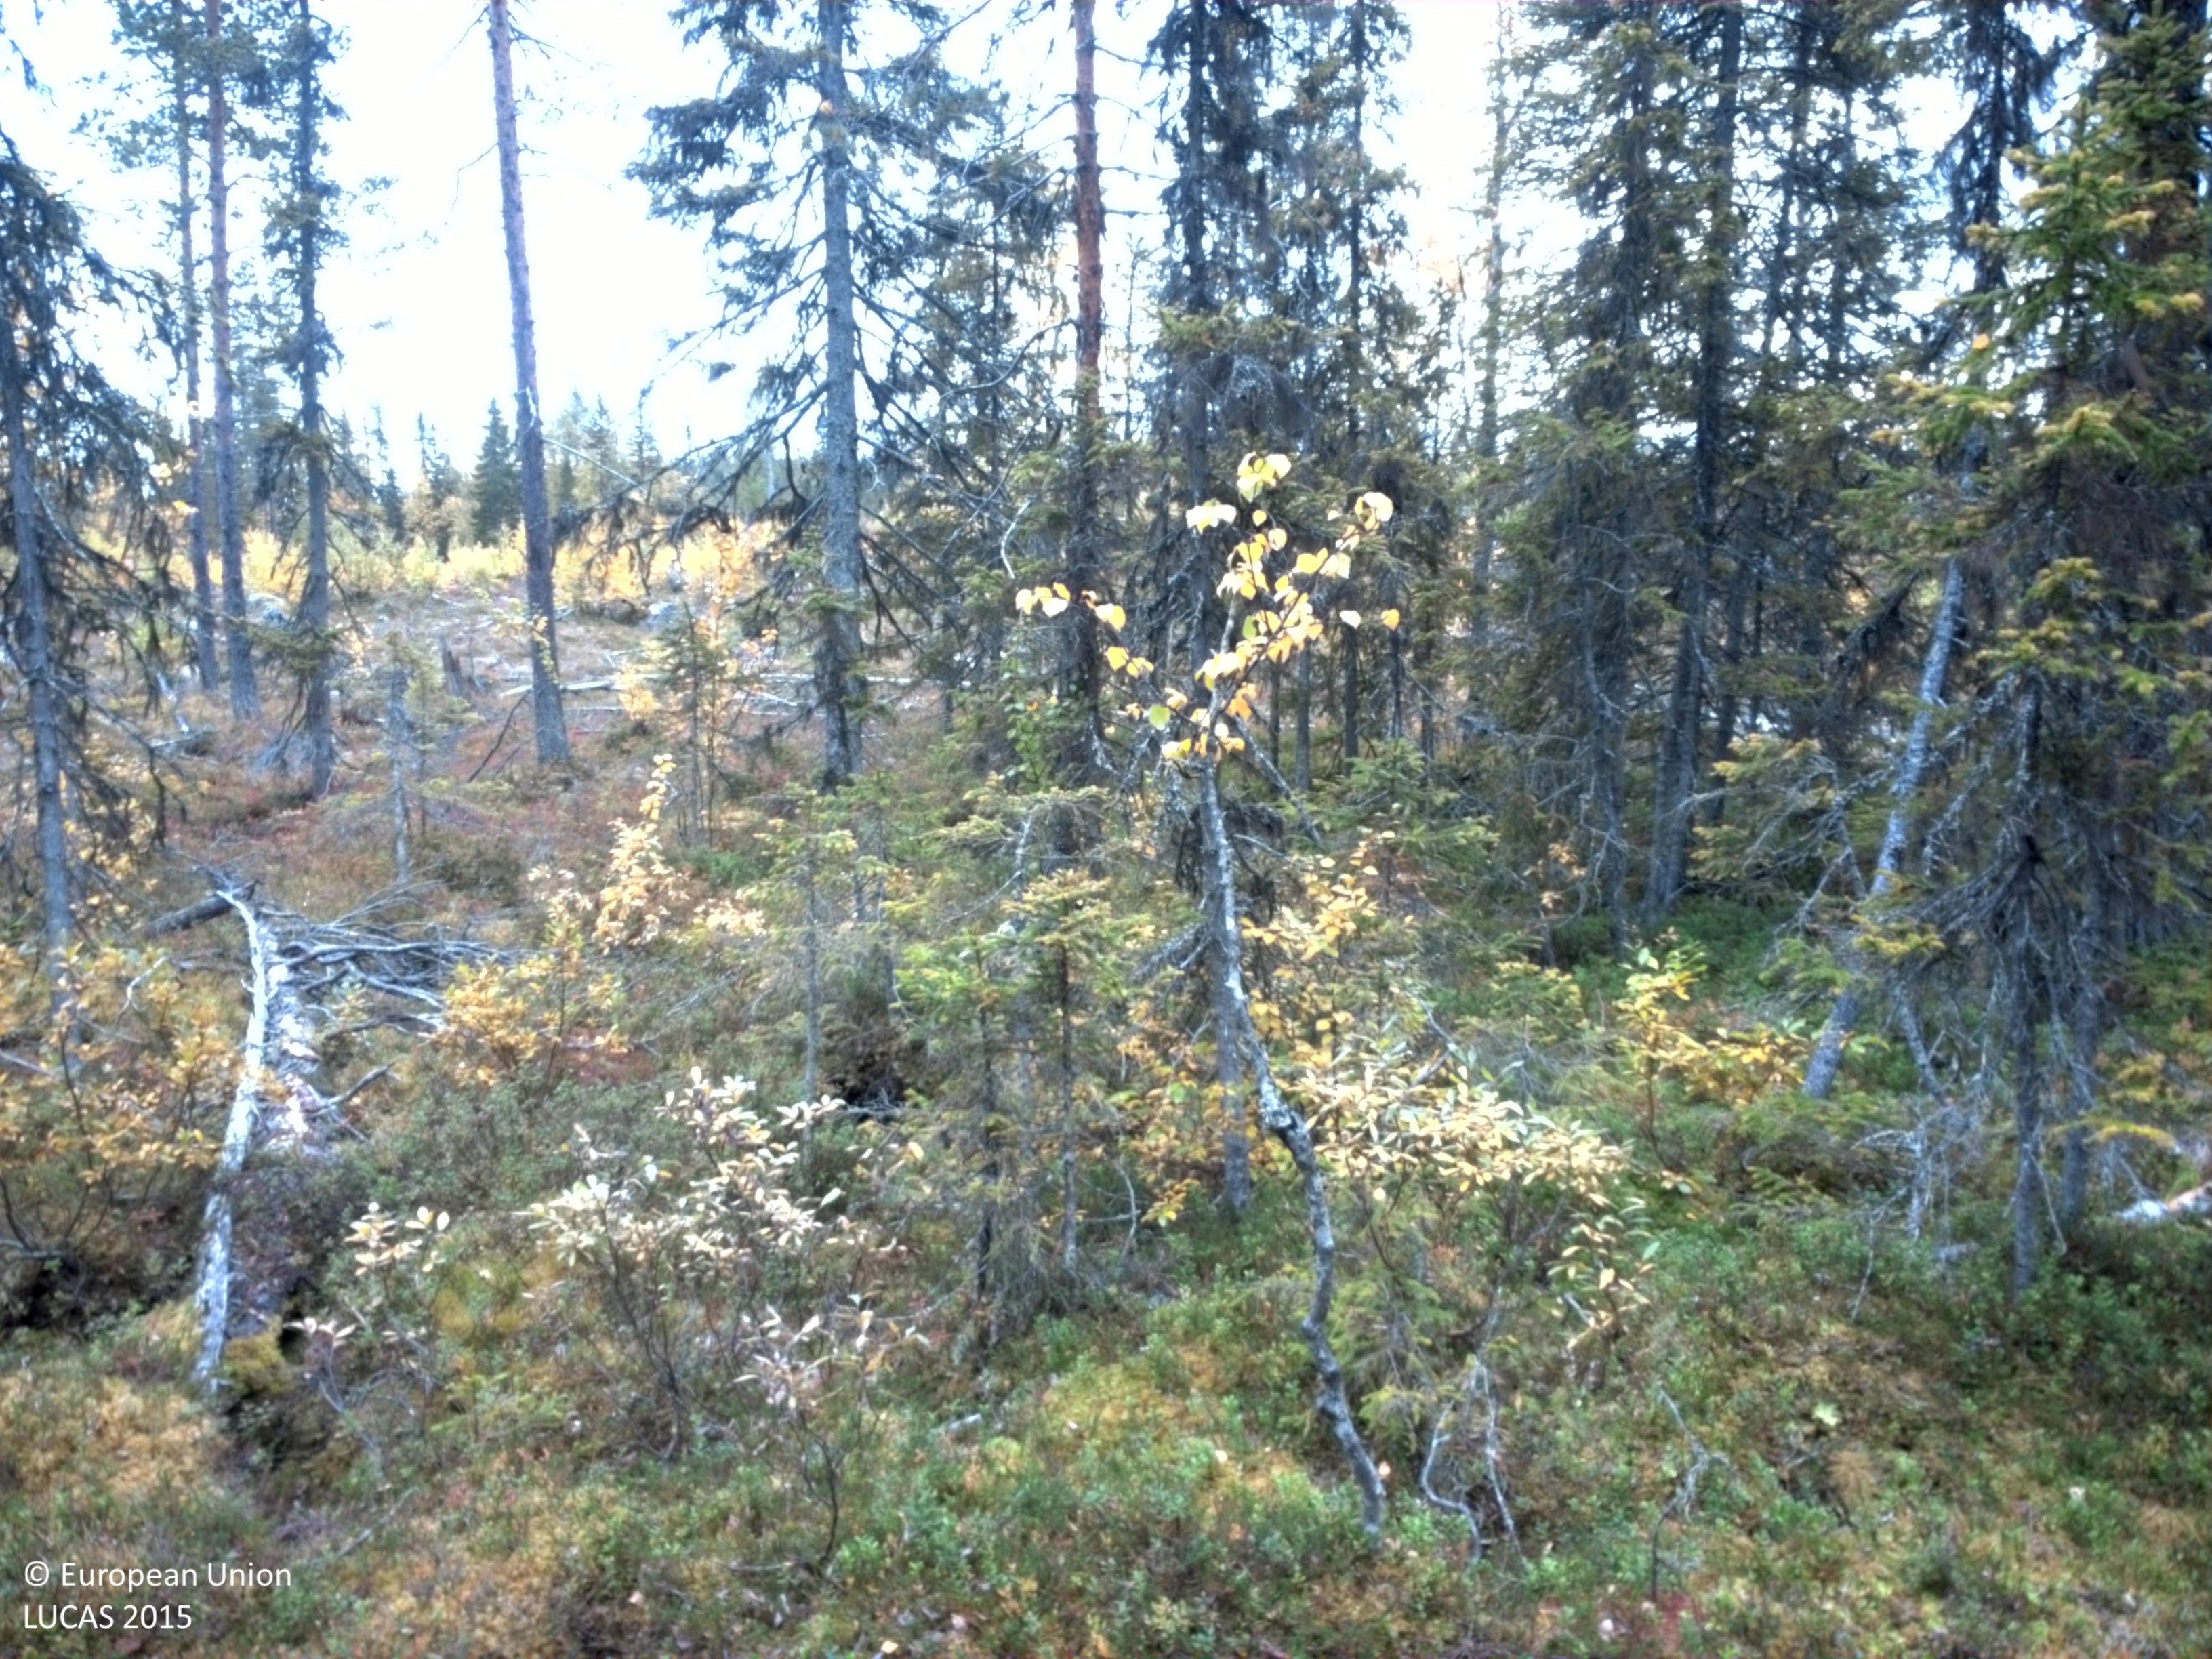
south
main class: Woodland
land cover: Spruce dominated coniferous woodland
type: boreal forest
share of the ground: 25 - 50 %
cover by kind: shrubs 40 %, coniferous forest trees 35 %, lichens and mosses 15 %, broadleaved forest trees 5 %, herbaceous plants 5 %
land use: Forestry
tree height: > 5 m
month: September
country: SE
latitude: 65.1176
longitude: 16.9284
